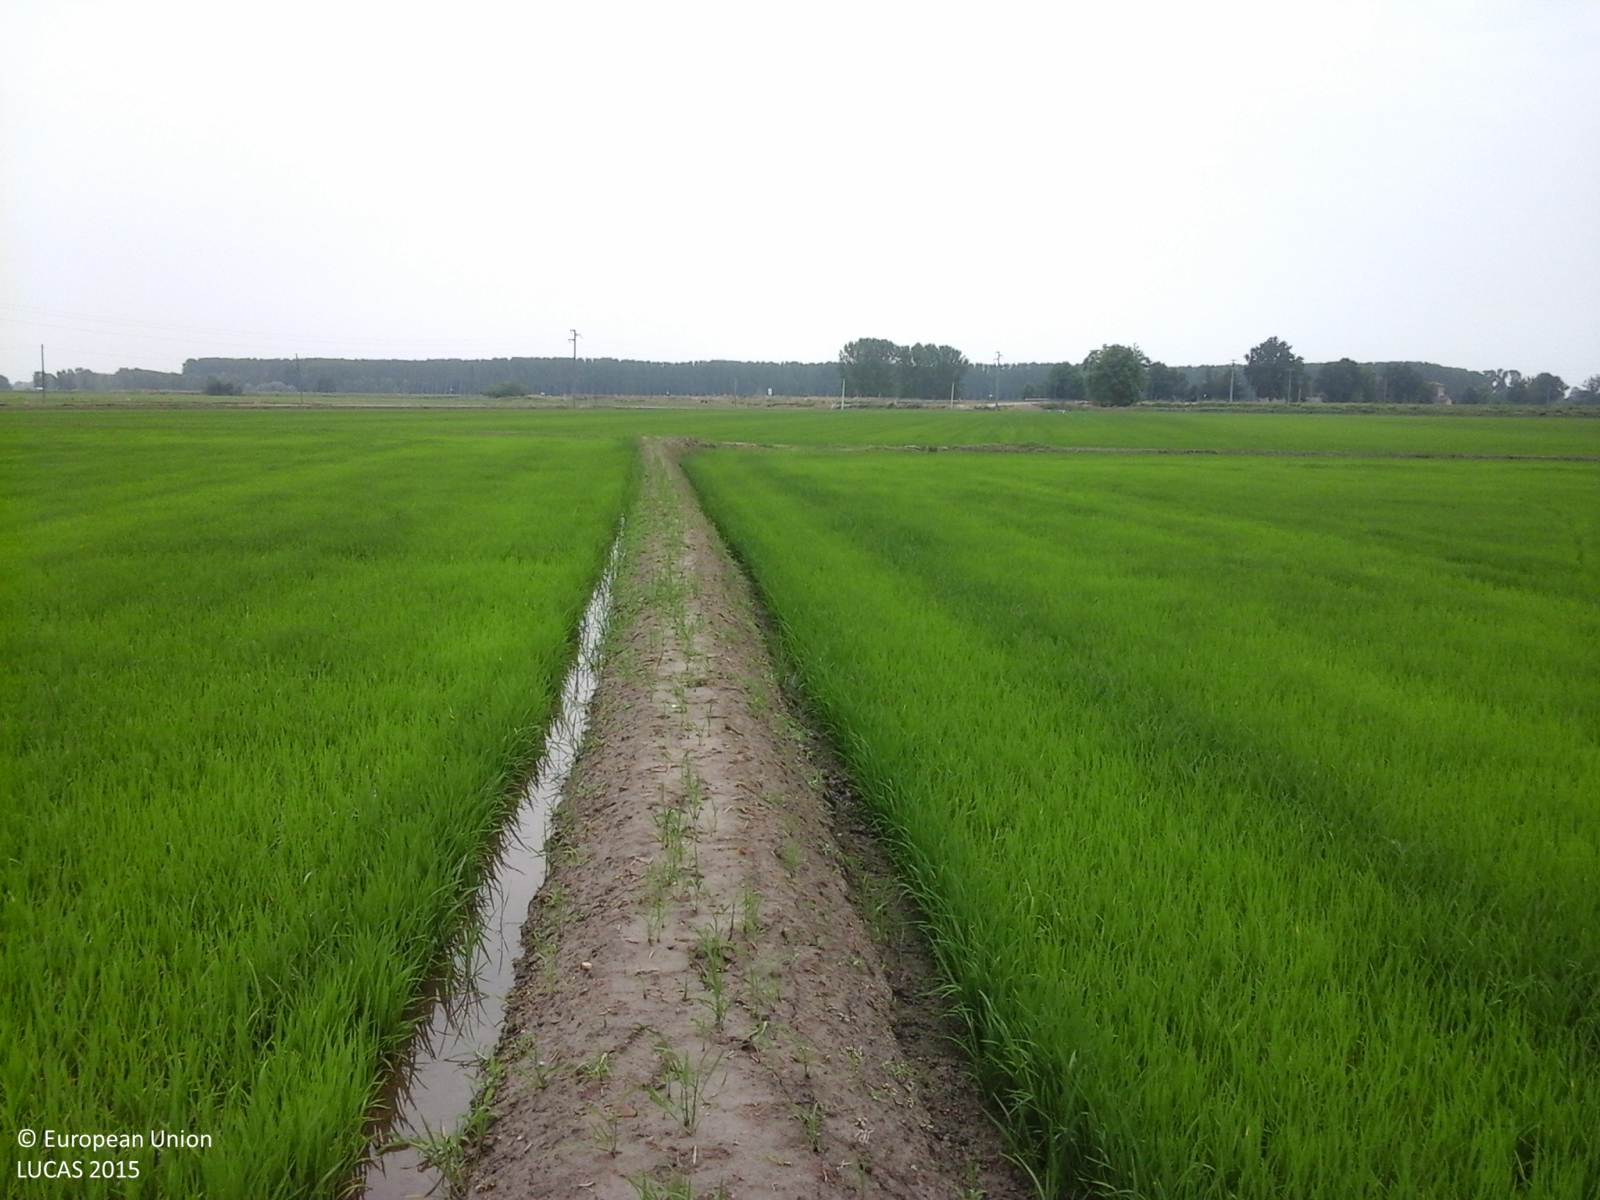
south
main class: Cropland
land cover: Rice
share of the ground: > 75 %
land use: Agriculture (excluding fallow land and kitchen gardens)
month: June
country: IT
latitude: 45.3136
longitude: 8.5102
